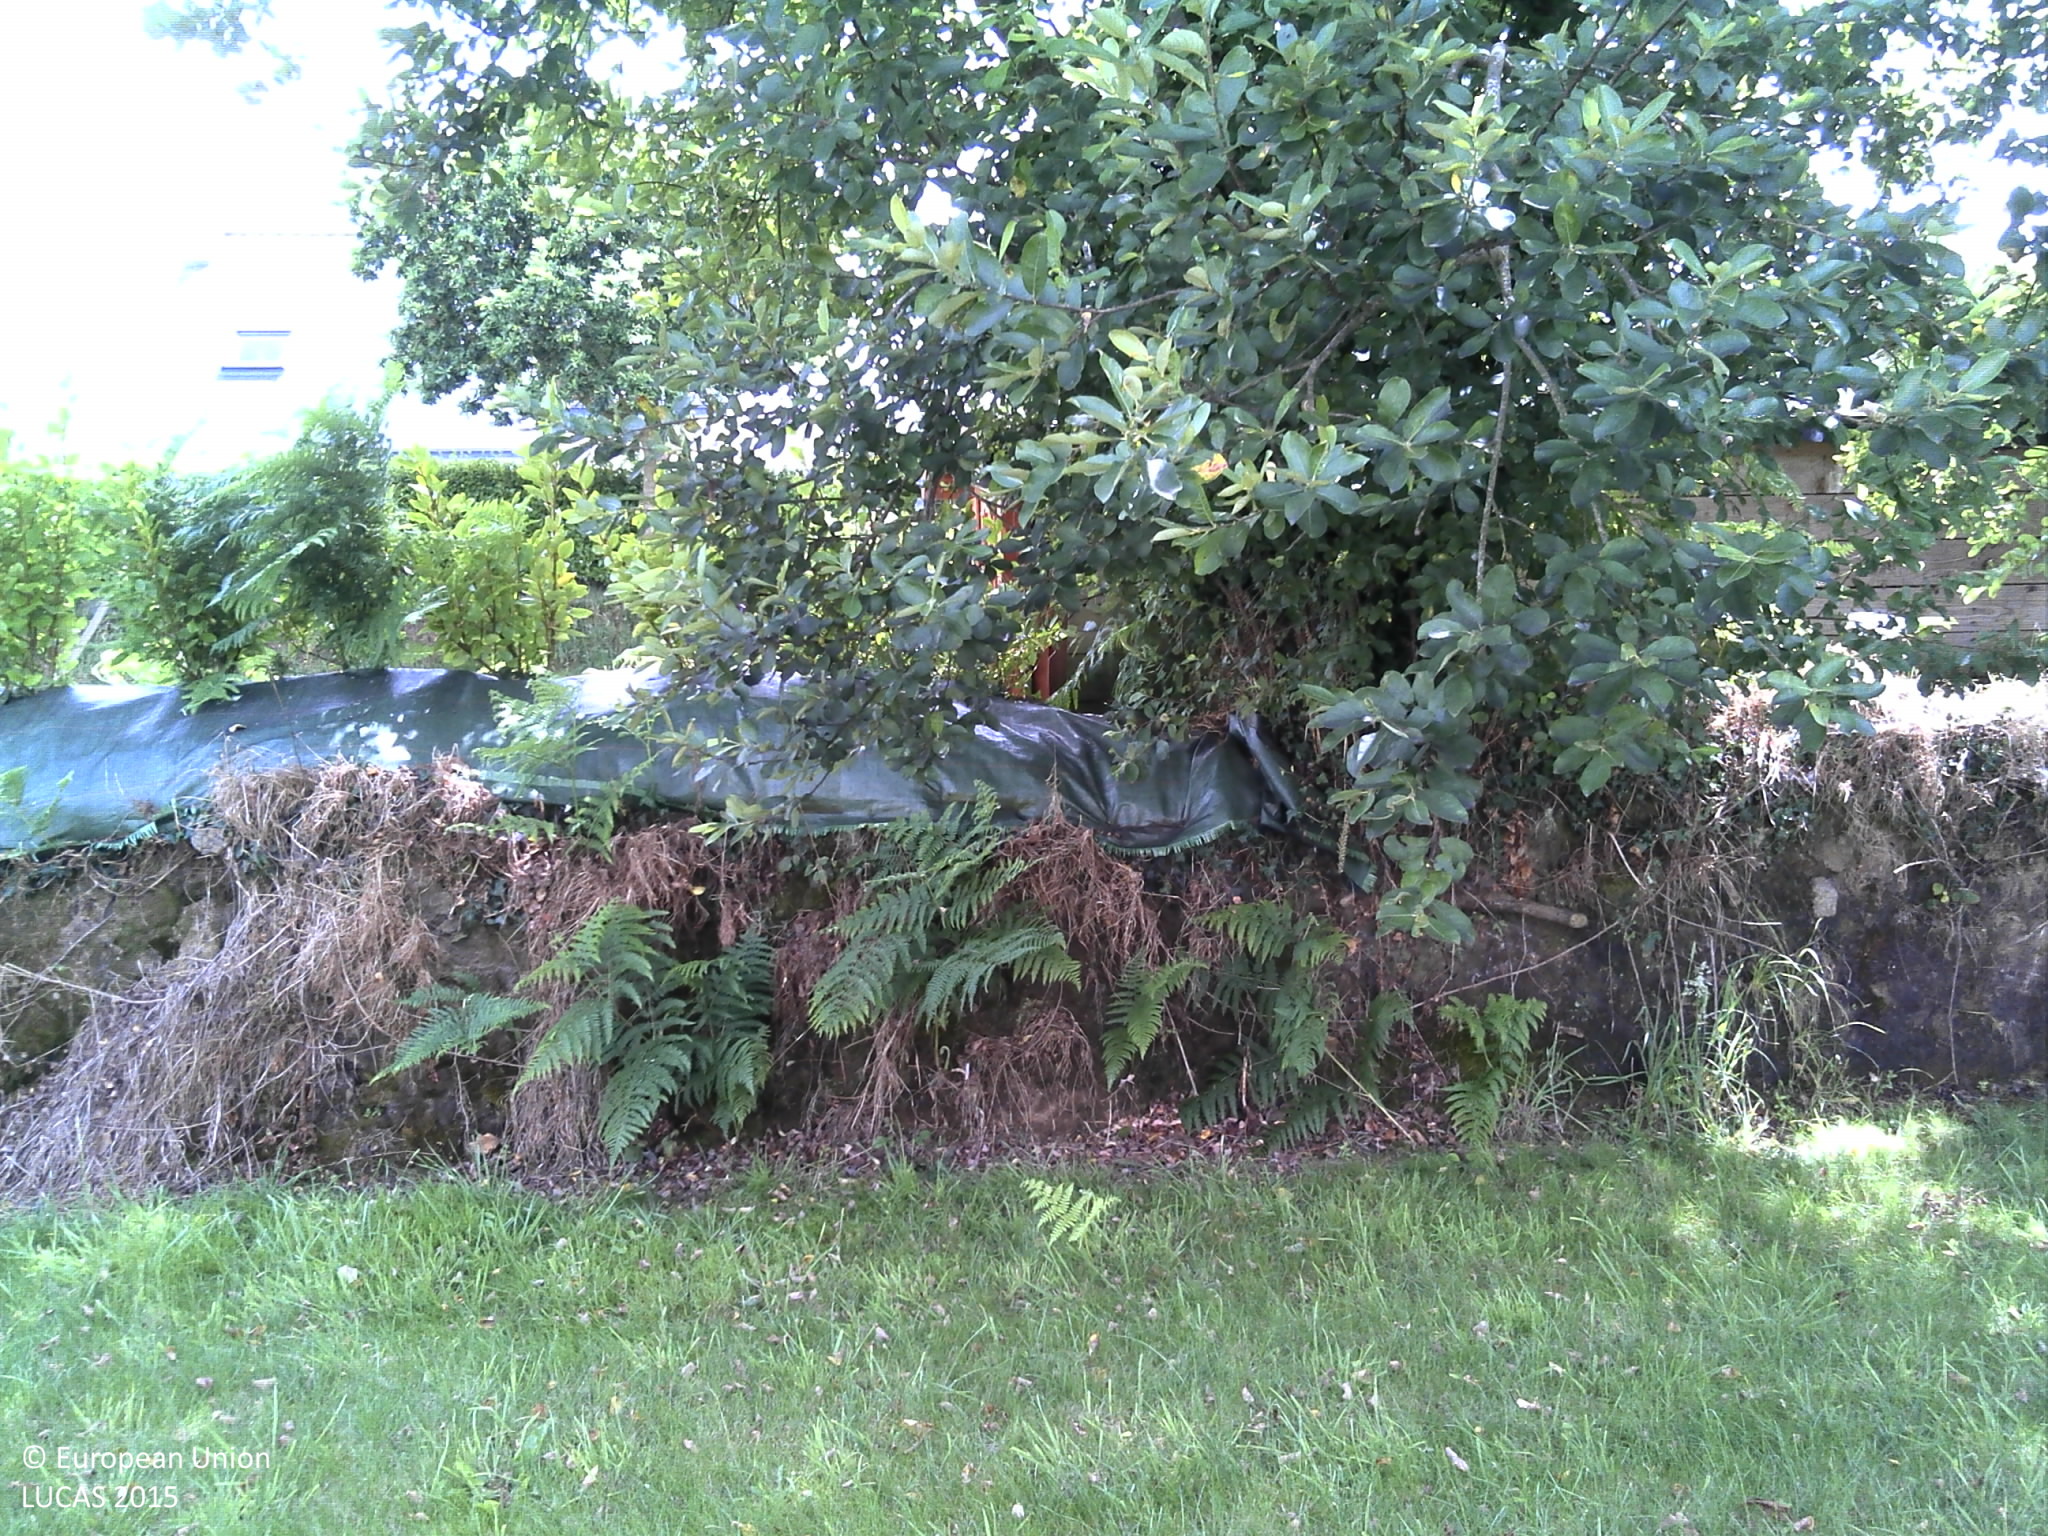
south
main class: Grassland
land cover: Grassland without tree/shrub cover
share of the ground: > 75 %
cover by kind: herbaceous plants 100 %
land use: Logistics and storage
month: July
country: FR
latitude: 48.5243
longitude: -4.6030
